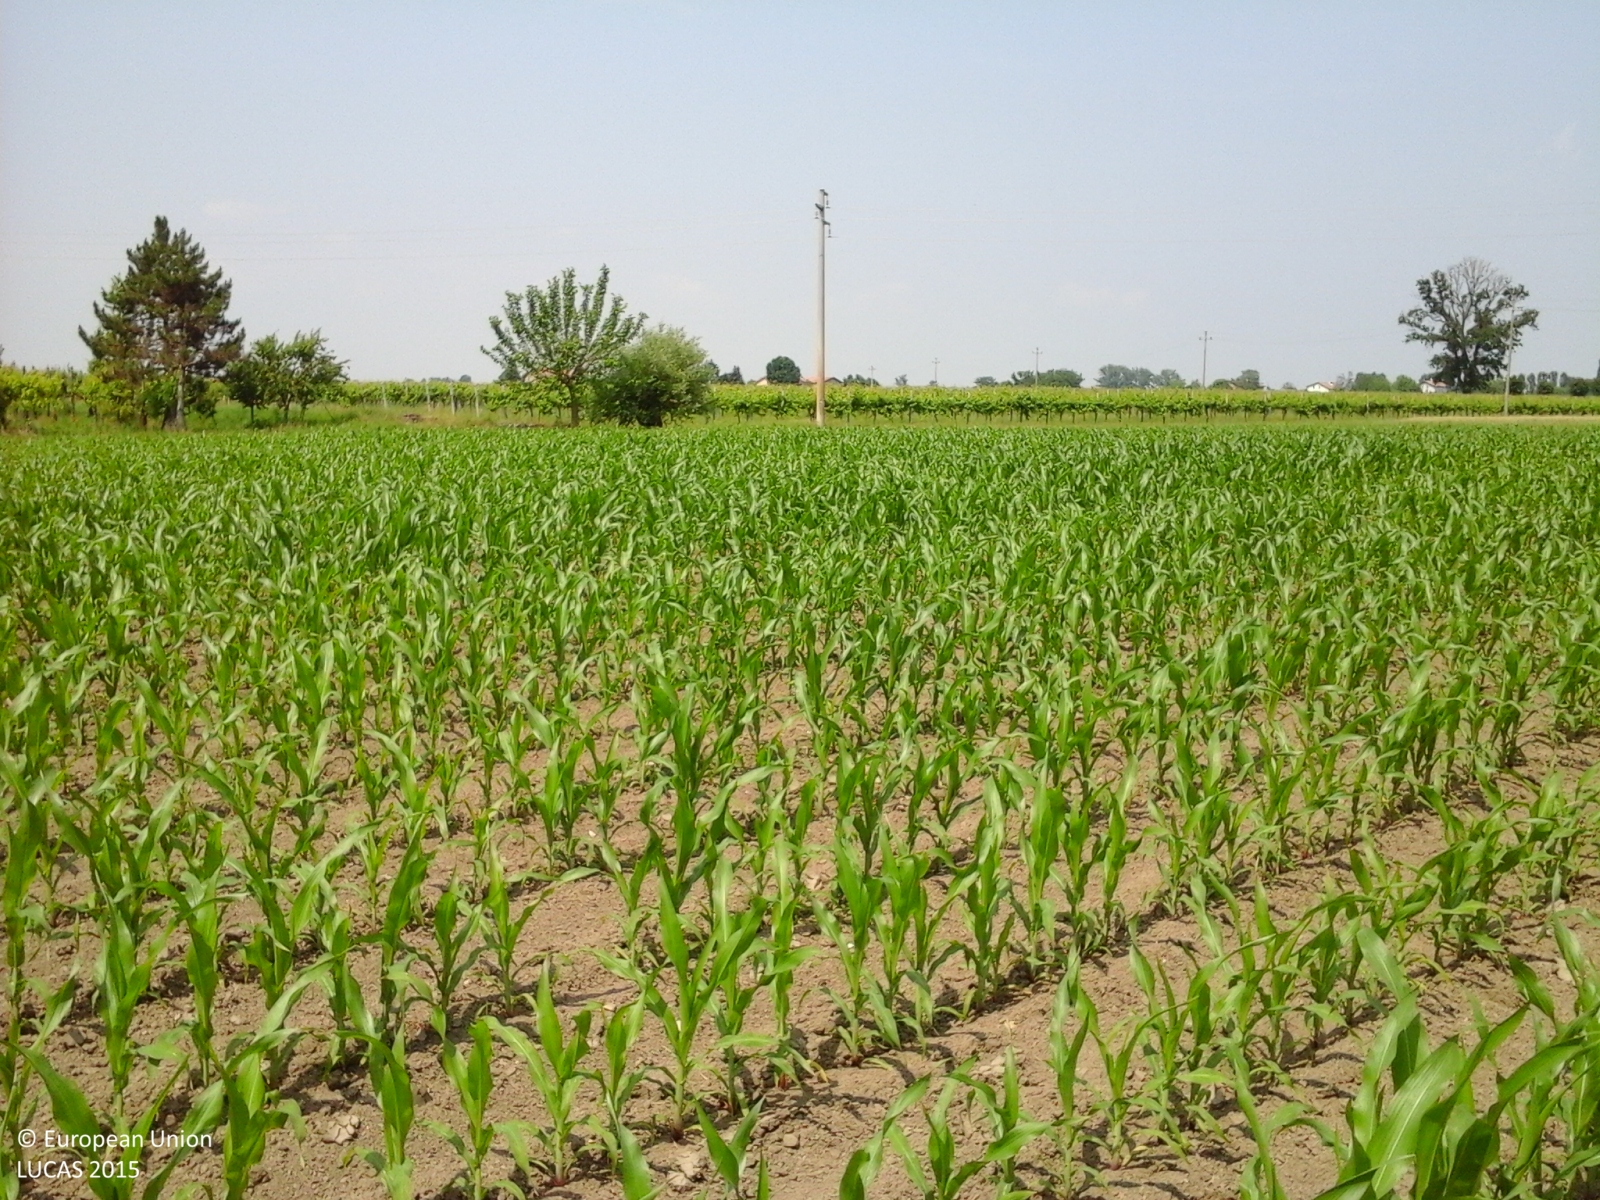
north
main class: Cropland
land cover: Maize
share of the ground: 50 - 75 %
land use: Agriculture (excluding fallow land and kitchen gardens)
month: May
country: IT
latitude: 44.7809
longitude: 10.7189
